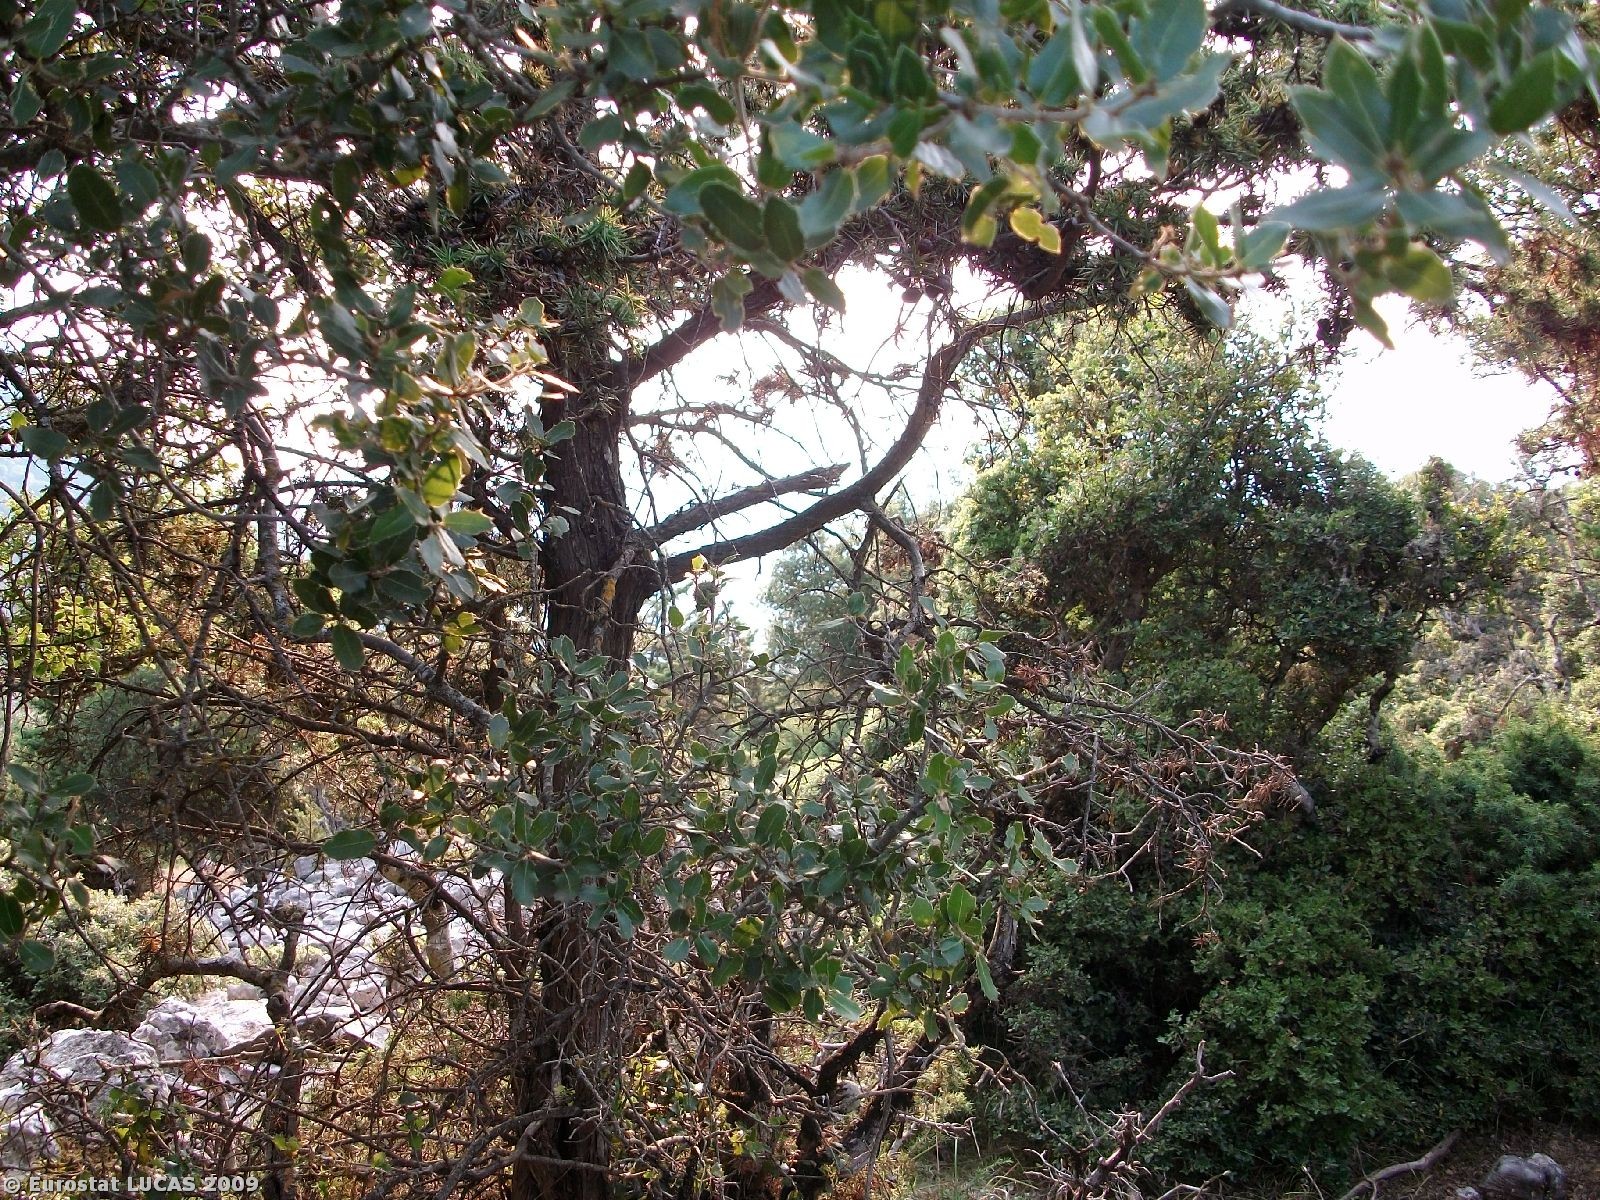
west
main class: Woodland
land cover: Broadleaved woodland
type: thermophilous deciduous forest
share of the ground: > 75 %
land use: Forestry
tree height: > 5 m
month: August
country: GR
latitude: 38.9562
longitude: 21.5954
